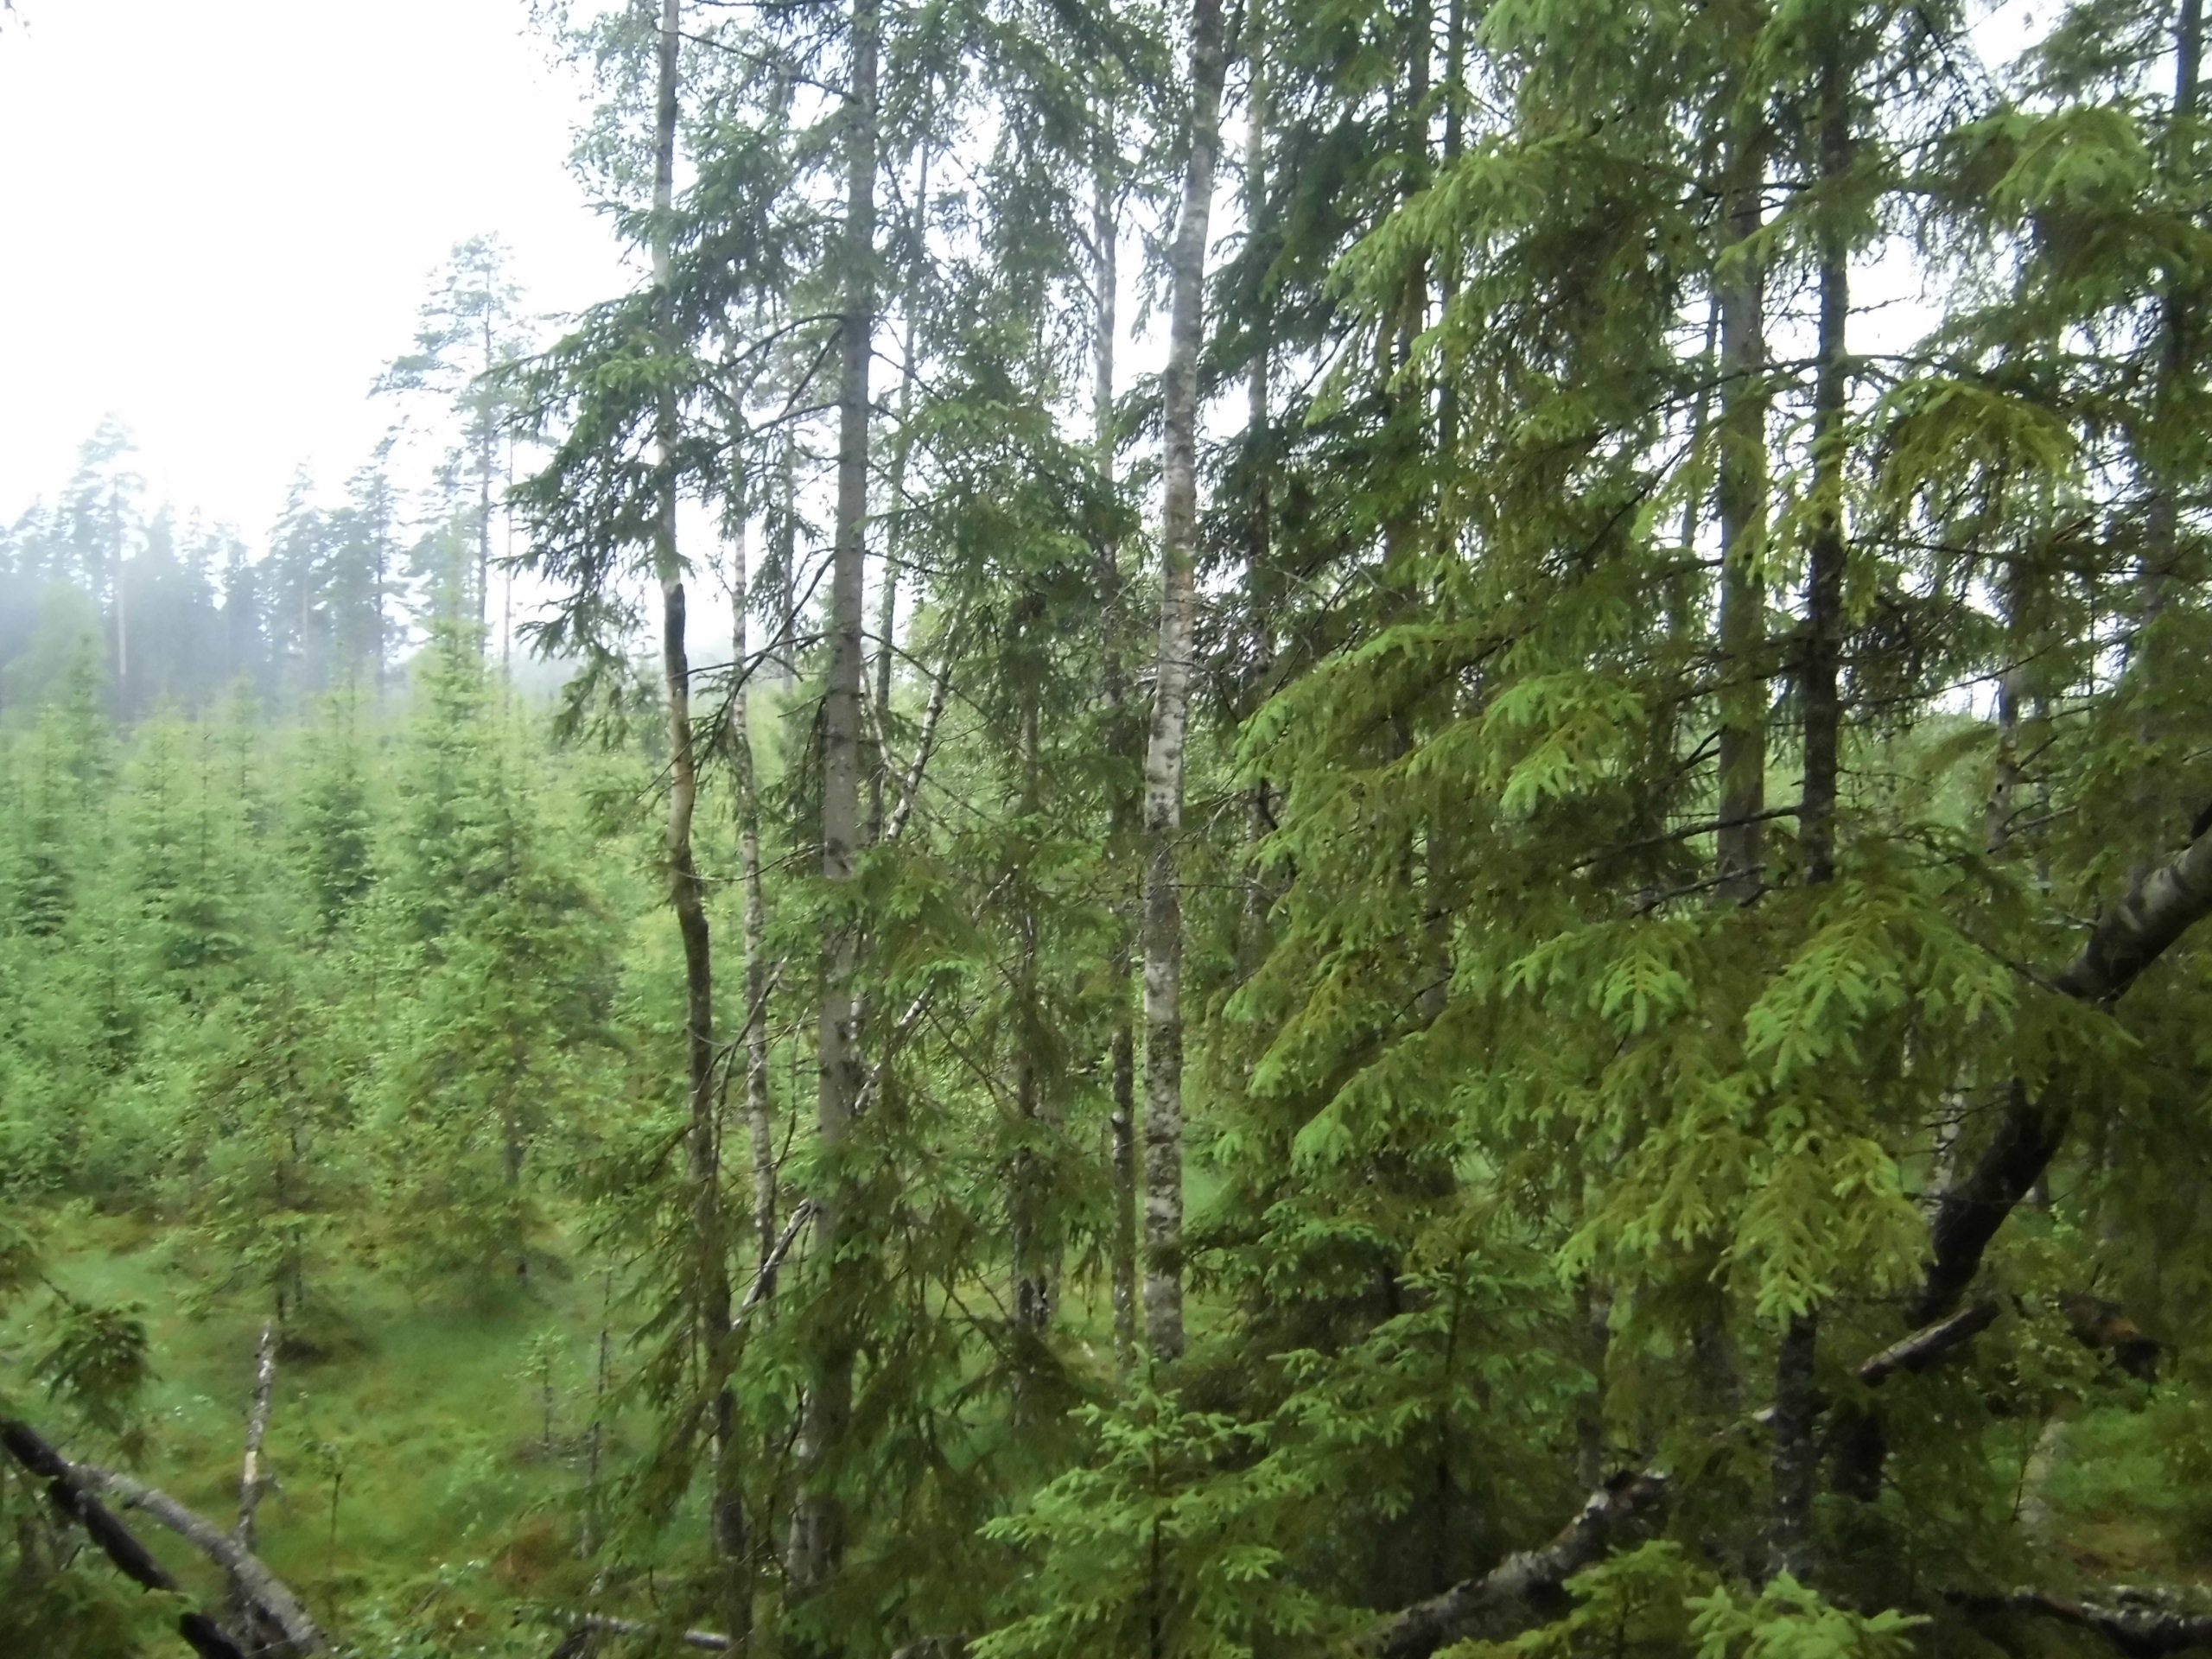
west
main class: Woodland
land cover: Spruce dominated coniferous woodland
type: boreal forest
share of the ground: 50 - 75 %
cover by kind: coniferous forest trees 45 %, shrubs 25 %, lichens and mosses 15 %, herbaceous plants 10 %, broadleaved forest trees 5 %
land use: Forestry
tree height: > 5 m
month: July
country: SE
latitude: 57.2211
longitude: 15.1142
